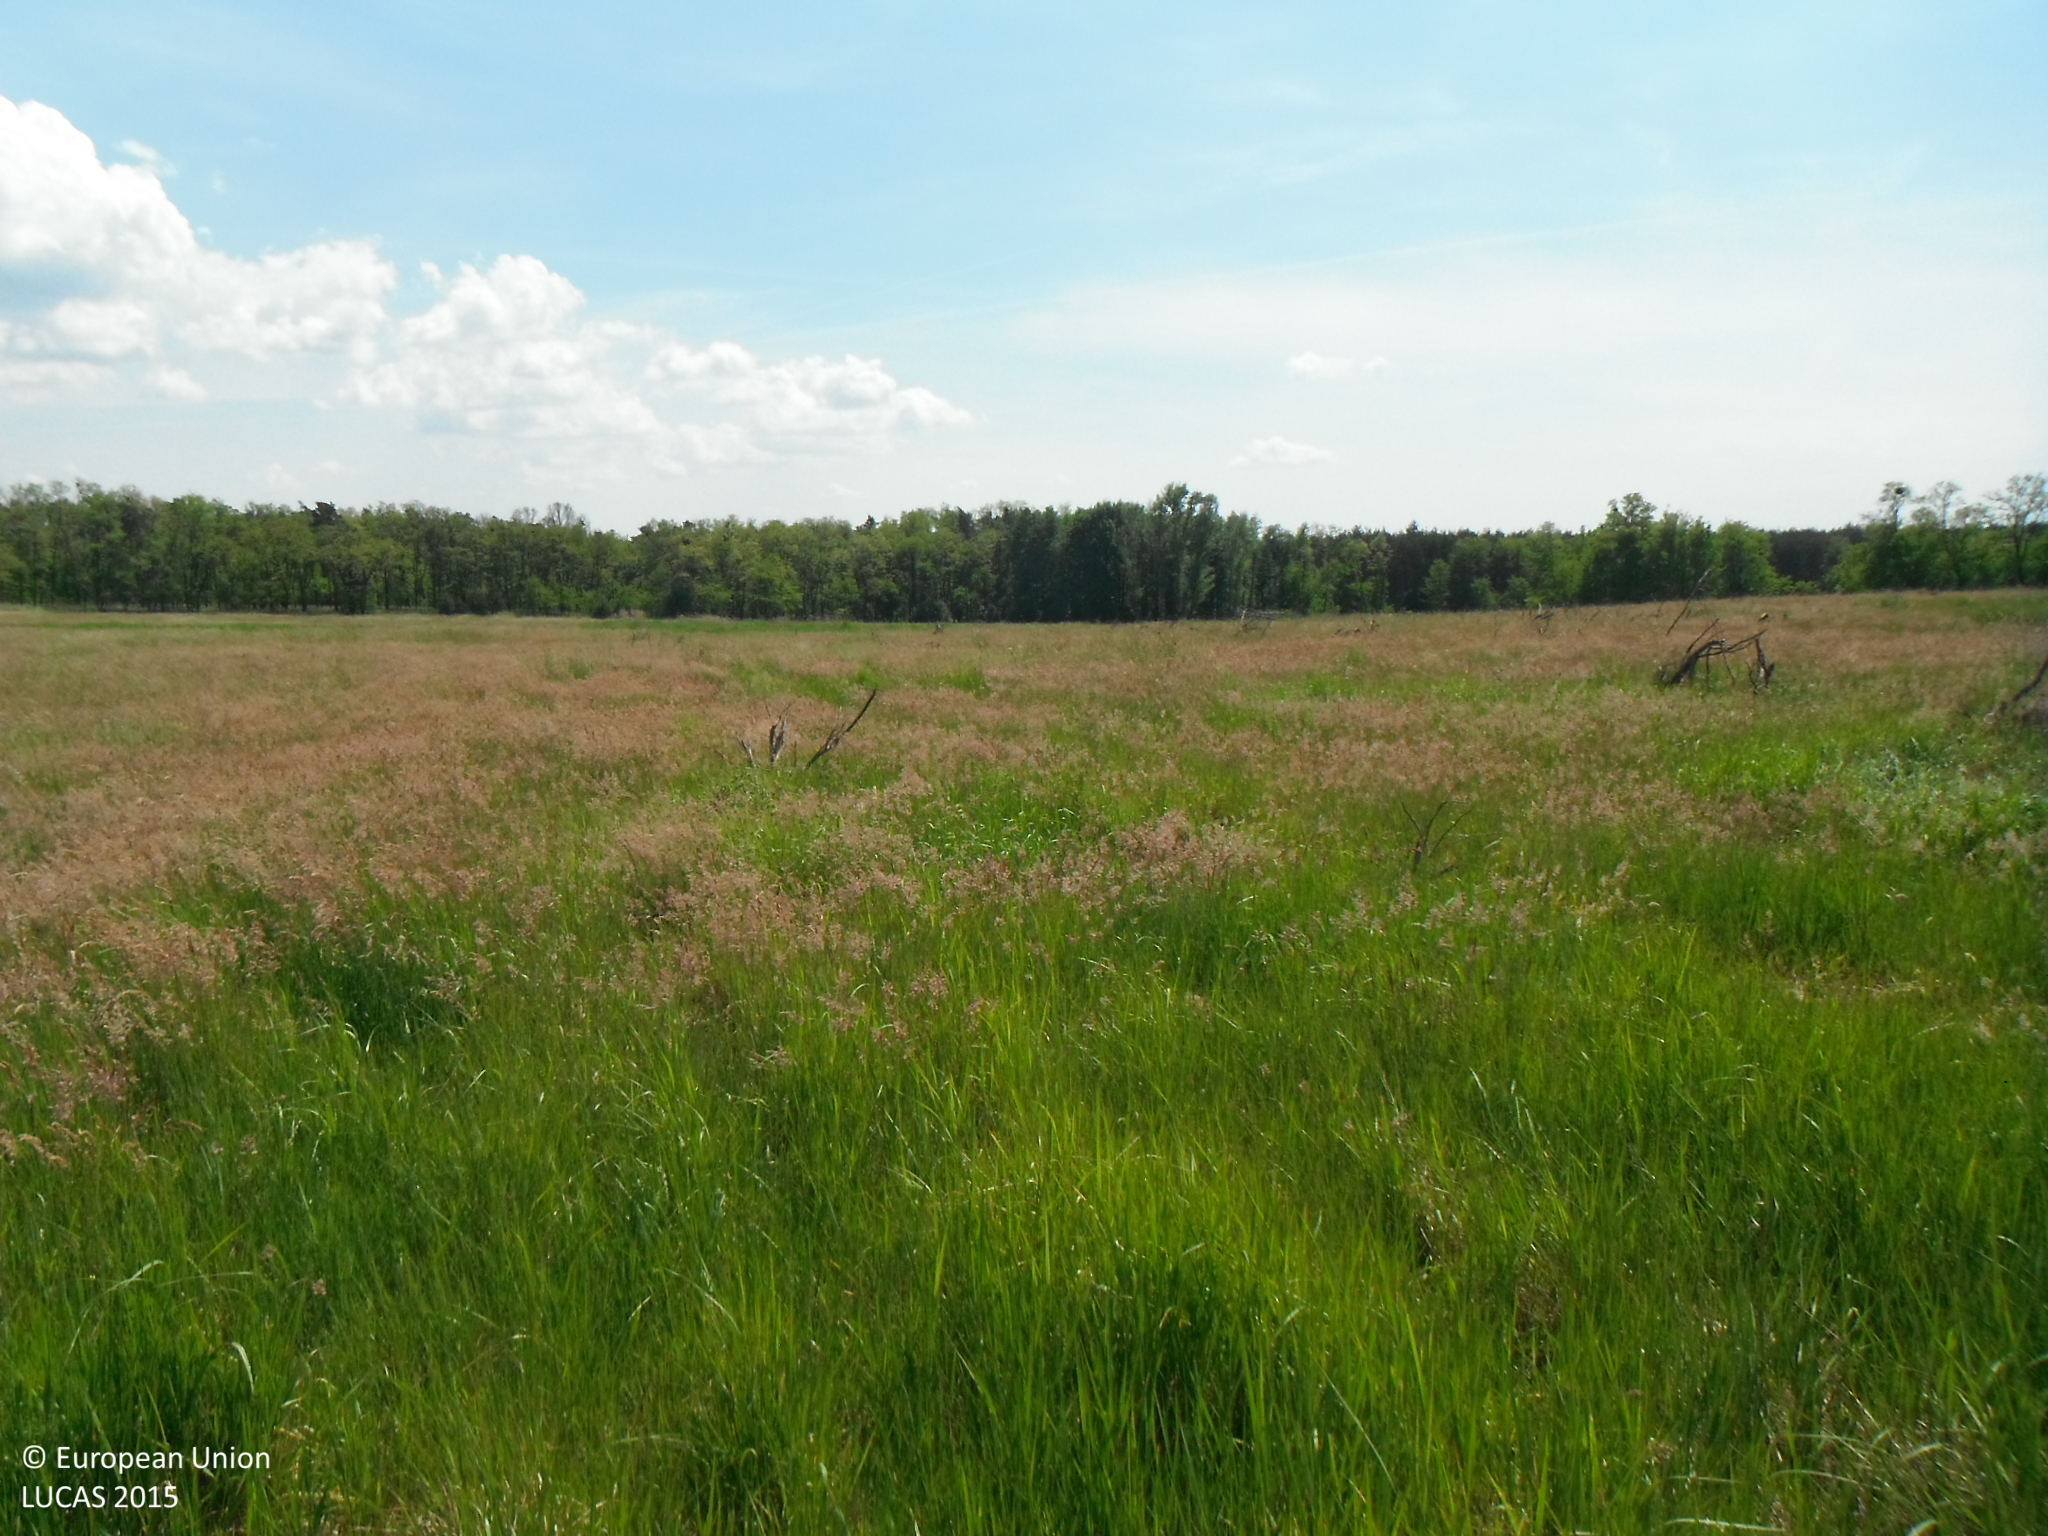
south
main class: Grassland
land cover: Grassland without tree/shrub cover
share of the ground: > 75 %
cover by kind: herbaceous plants 100 %
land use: Agriculture (excluding fallow land and kitchen gardens)
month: June
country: SK
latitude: 48.5940
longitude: 17.0455
